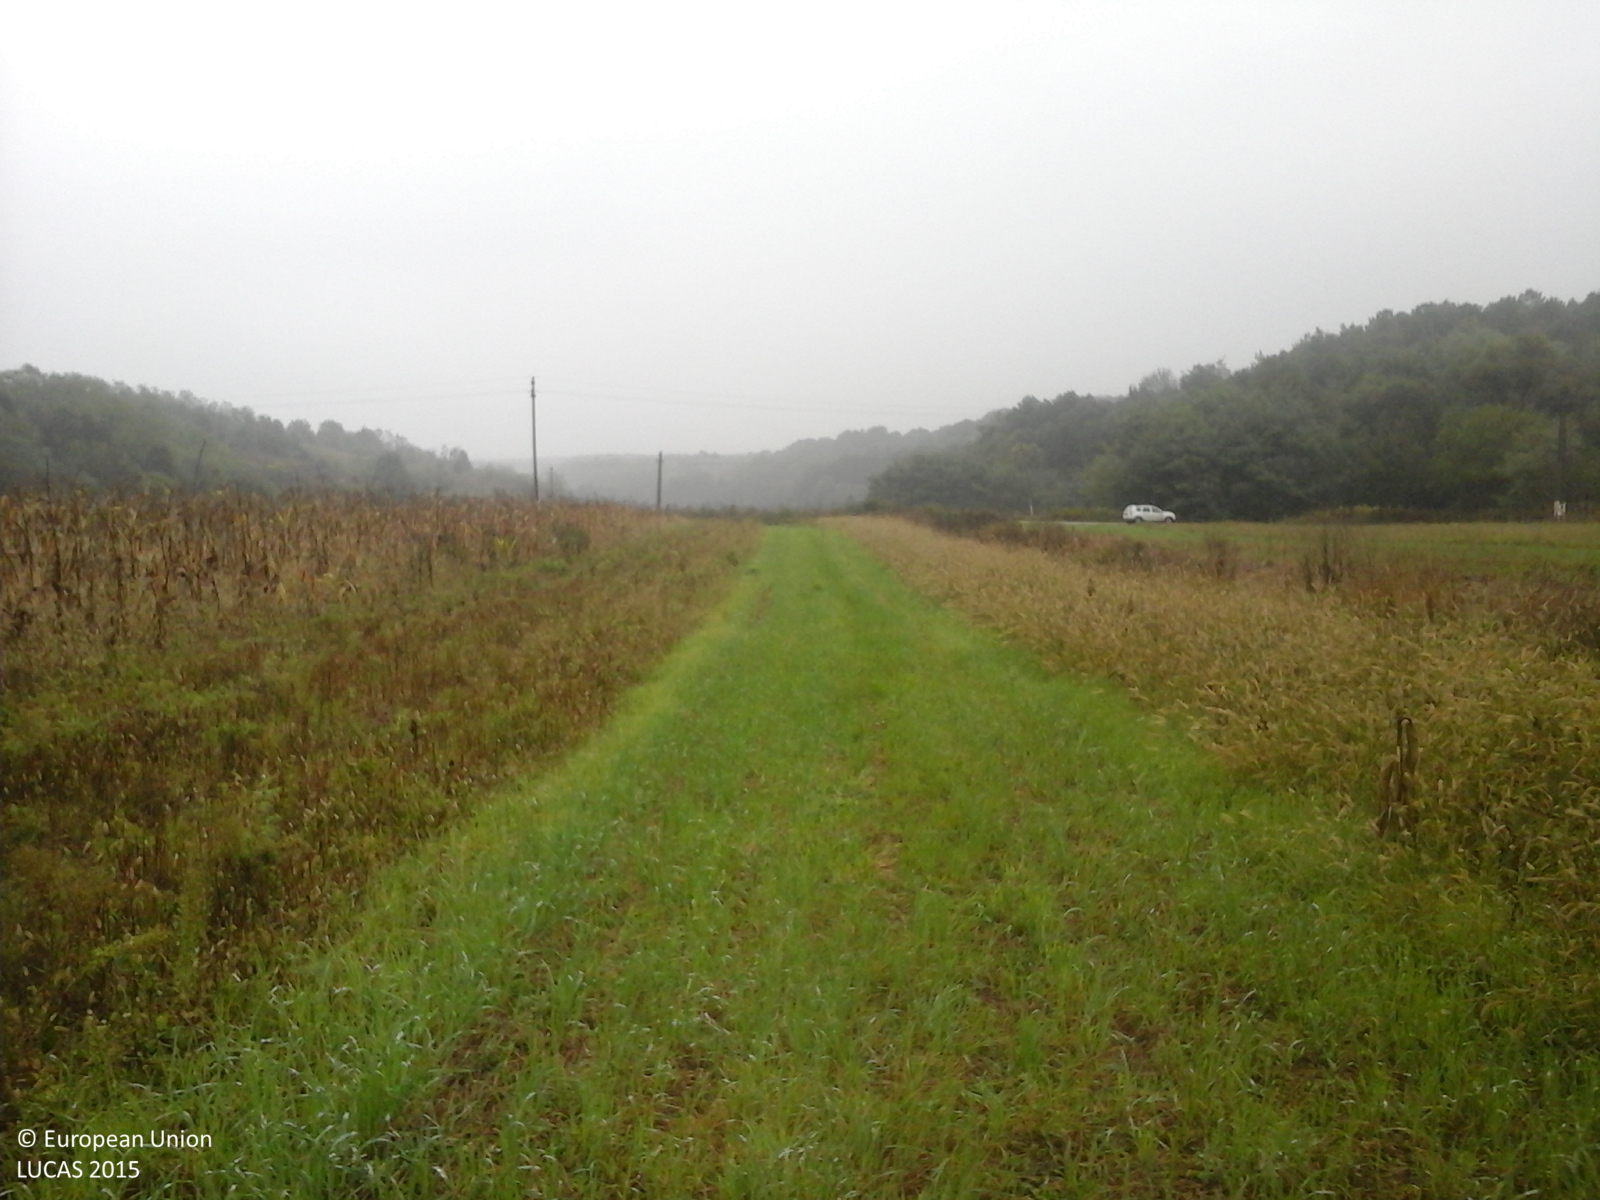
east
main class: Grassland
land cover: Grassland without tree/shrub cover
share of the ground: > 75 %
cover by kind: herbaceous plants 100 %
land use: Agriculture (excluding fallow land and kitchen gardens)
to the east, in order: Grassland without tree/shrub cover; Electric lines; Grassland without tree/shrub cover; Tracks; Ditches and canals; Paved roads, cycling and walking lanes; Ditches and canals; Electric lines; Spontaneously vegetated surfaces; Grassland without tree/shrub cover; Maize; Electric lines; Maize; Grassland without tree/shrub cover; Maize; Grassland without tree/shrub cover
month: September
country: RO
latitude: 44.9217
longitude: 23.5238
